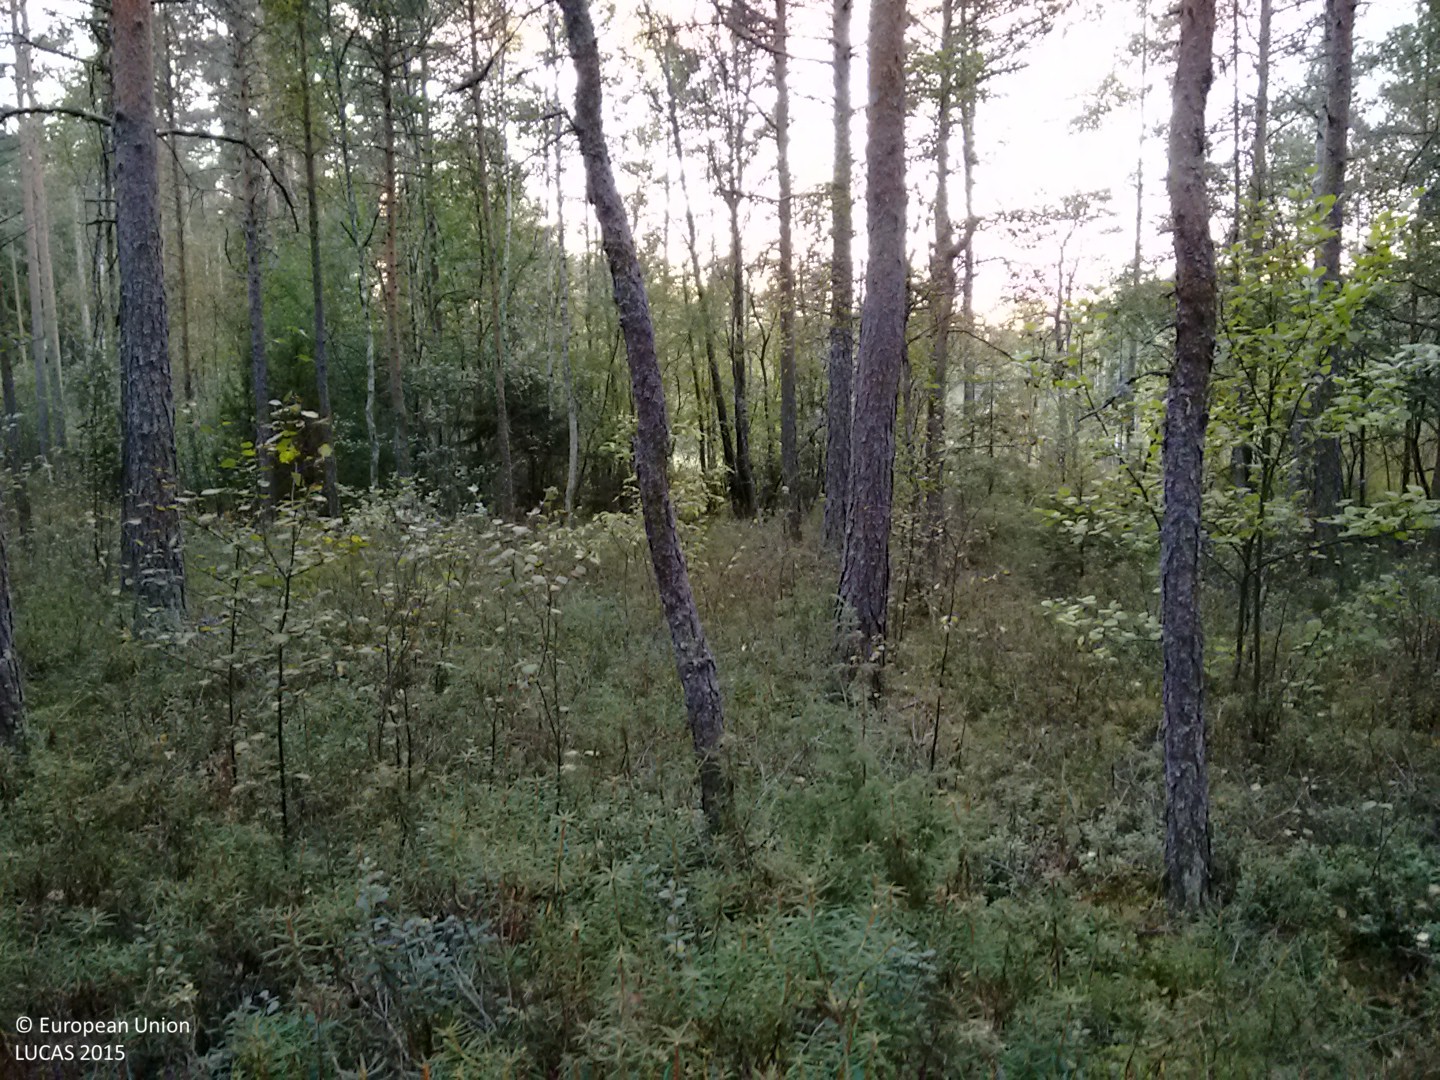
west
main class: Woodland
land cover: Pine dominated mixed woodland
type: hemiboreal forest and nemoral coniferous forest and mixed broadleaved-coniferous forest
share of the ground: > 75 %
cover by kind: coniferous forest trees 60 %, broadleaved forest trees 20 %, shrubs 20 %
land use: Forestry
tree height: > 5 m
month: September
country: FI
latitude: 60.9407
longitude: 21.5904
